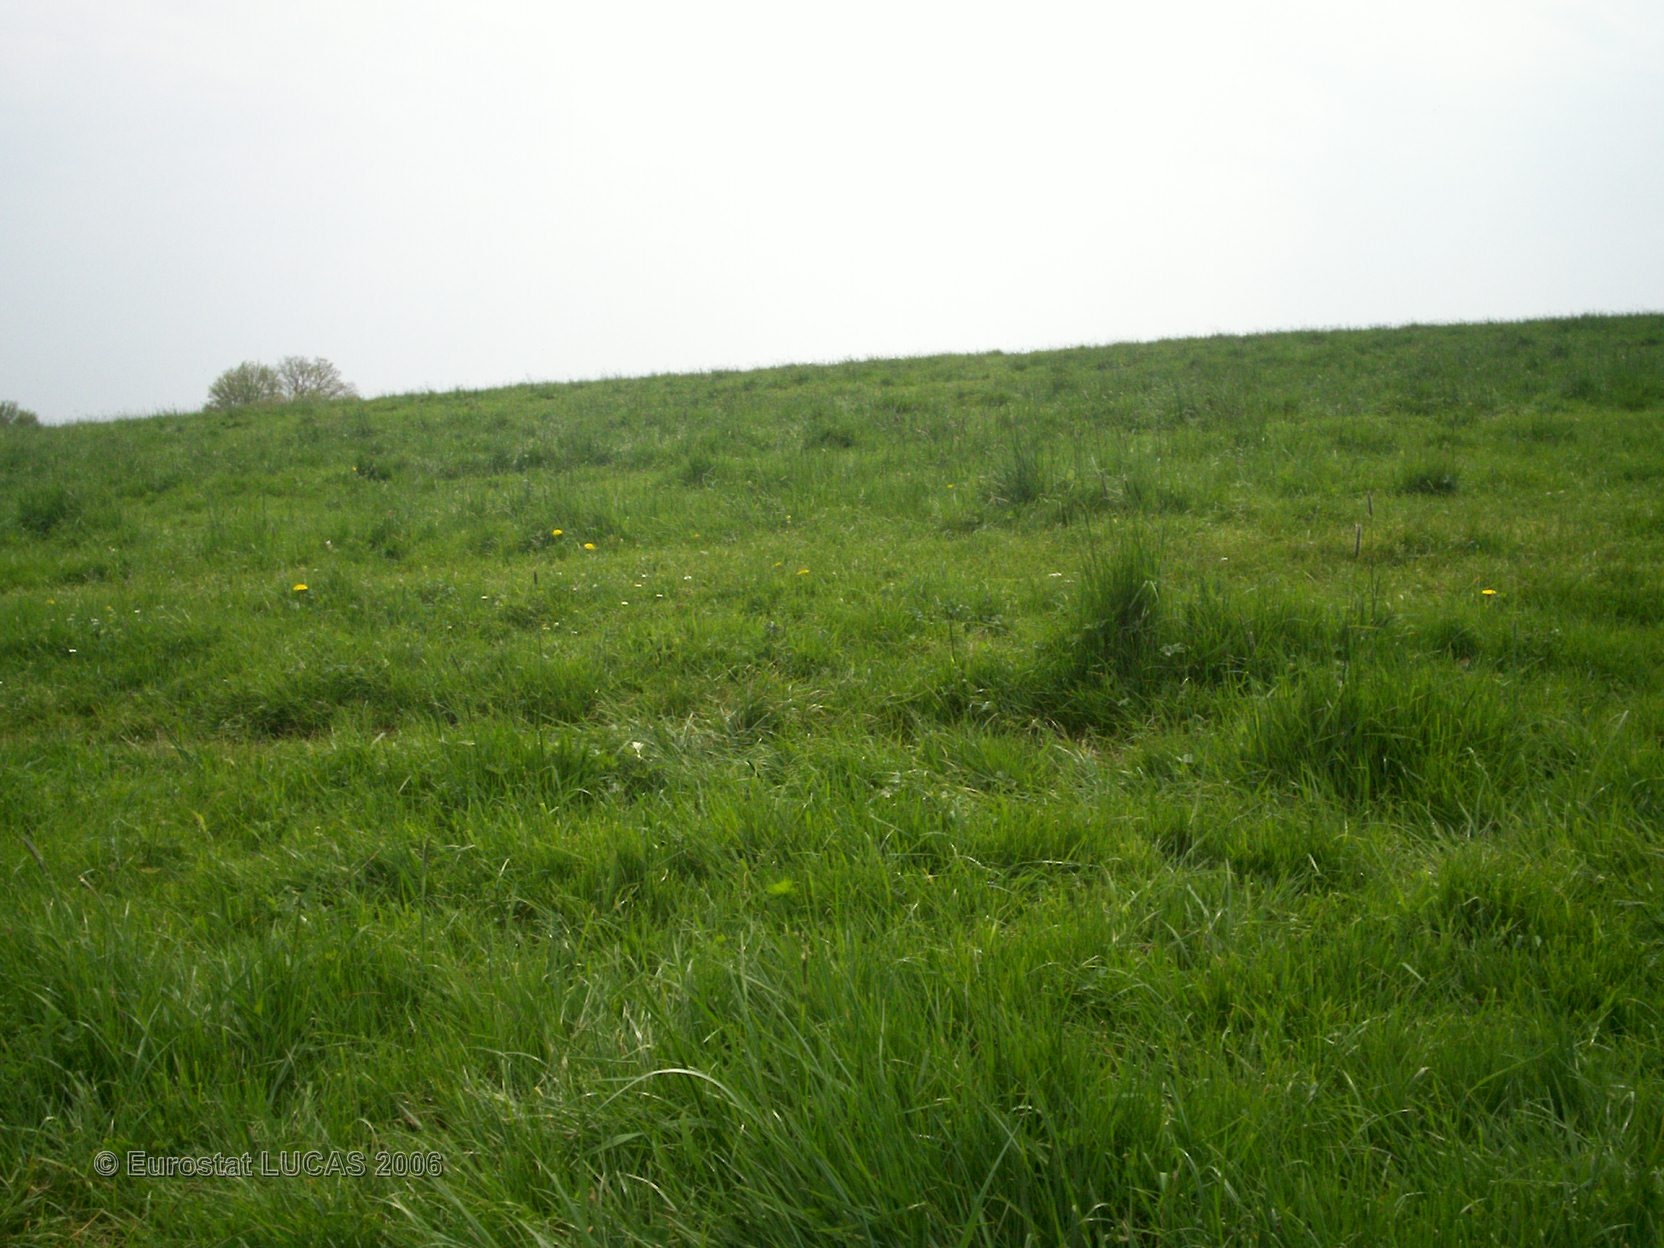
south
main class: Grassland
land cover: Grassland with sparse tree/shrub cover
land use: Agriculture (excluding fallow land and kitchen gardens)
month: May
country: FR
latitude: 48.8613
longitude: 6.7971
